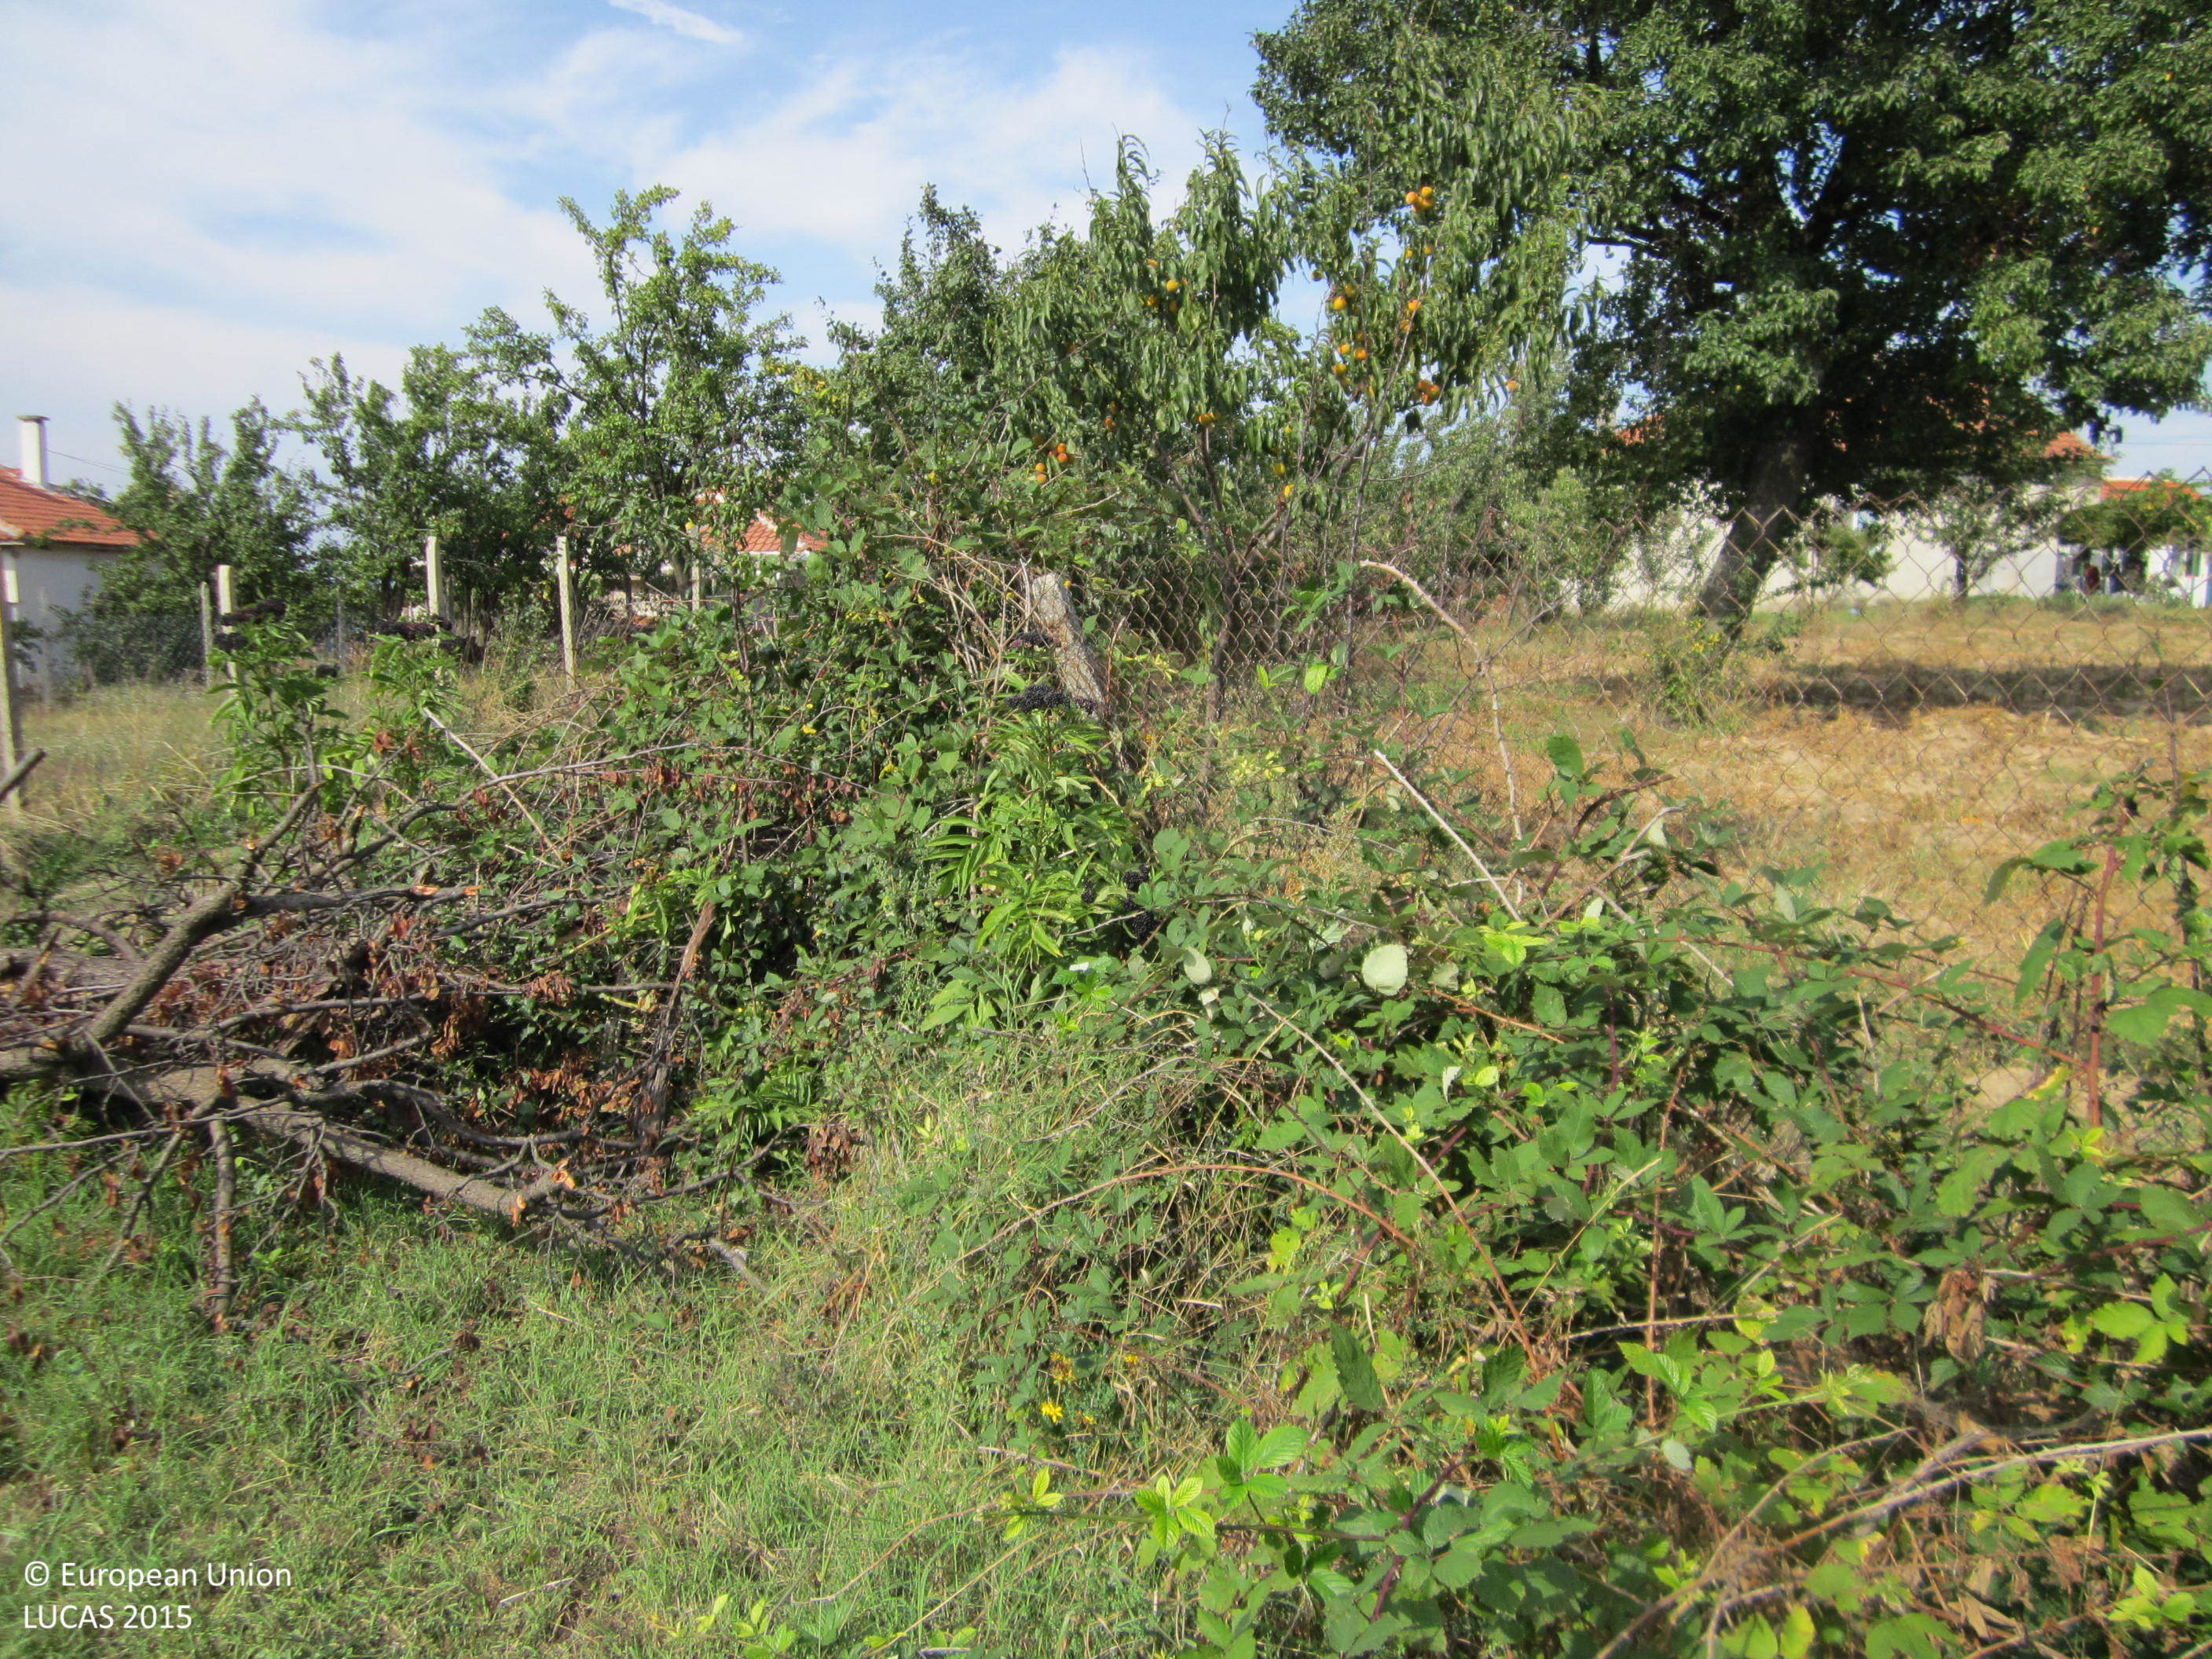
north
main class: Cropland
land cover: Potatoes
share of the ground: 25 - 50 %
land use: Kitchen garden
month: September
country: BG
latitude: 42.7785
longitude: 27.1635
